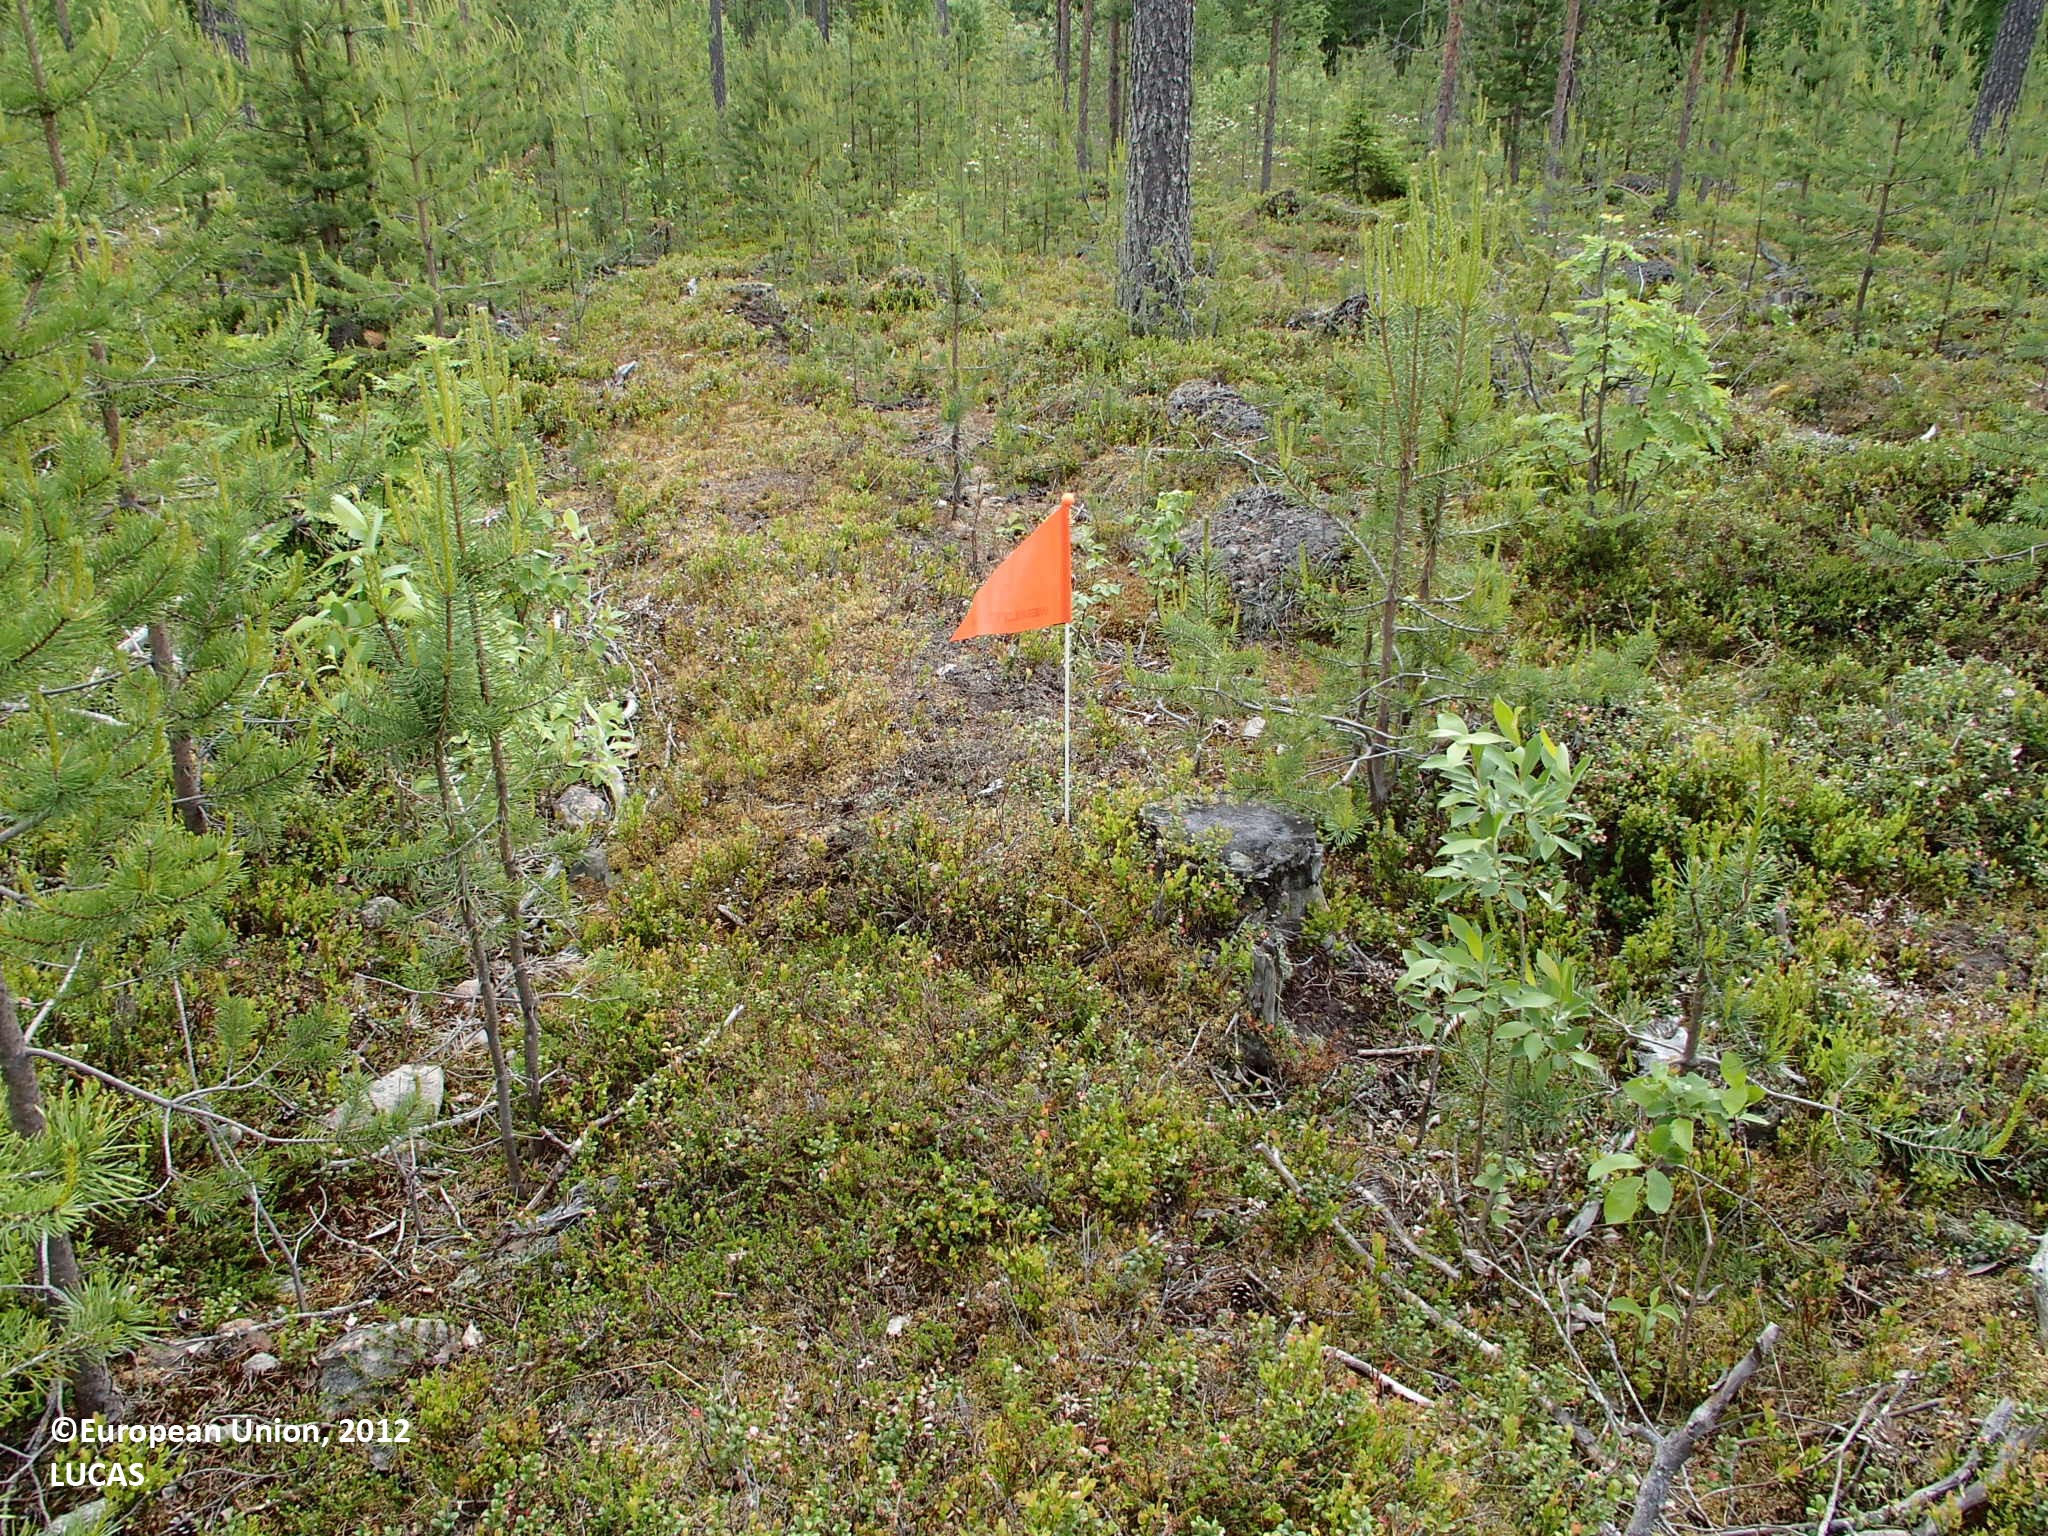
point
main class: Woodland
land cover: Pine dominated coniferous woodland
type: boreal forest
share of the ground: 10 - 25 %
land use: Forestry
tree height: > 5 m
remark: Clear cut
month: June
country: FI
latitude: 66.8218
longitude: 27.5275
